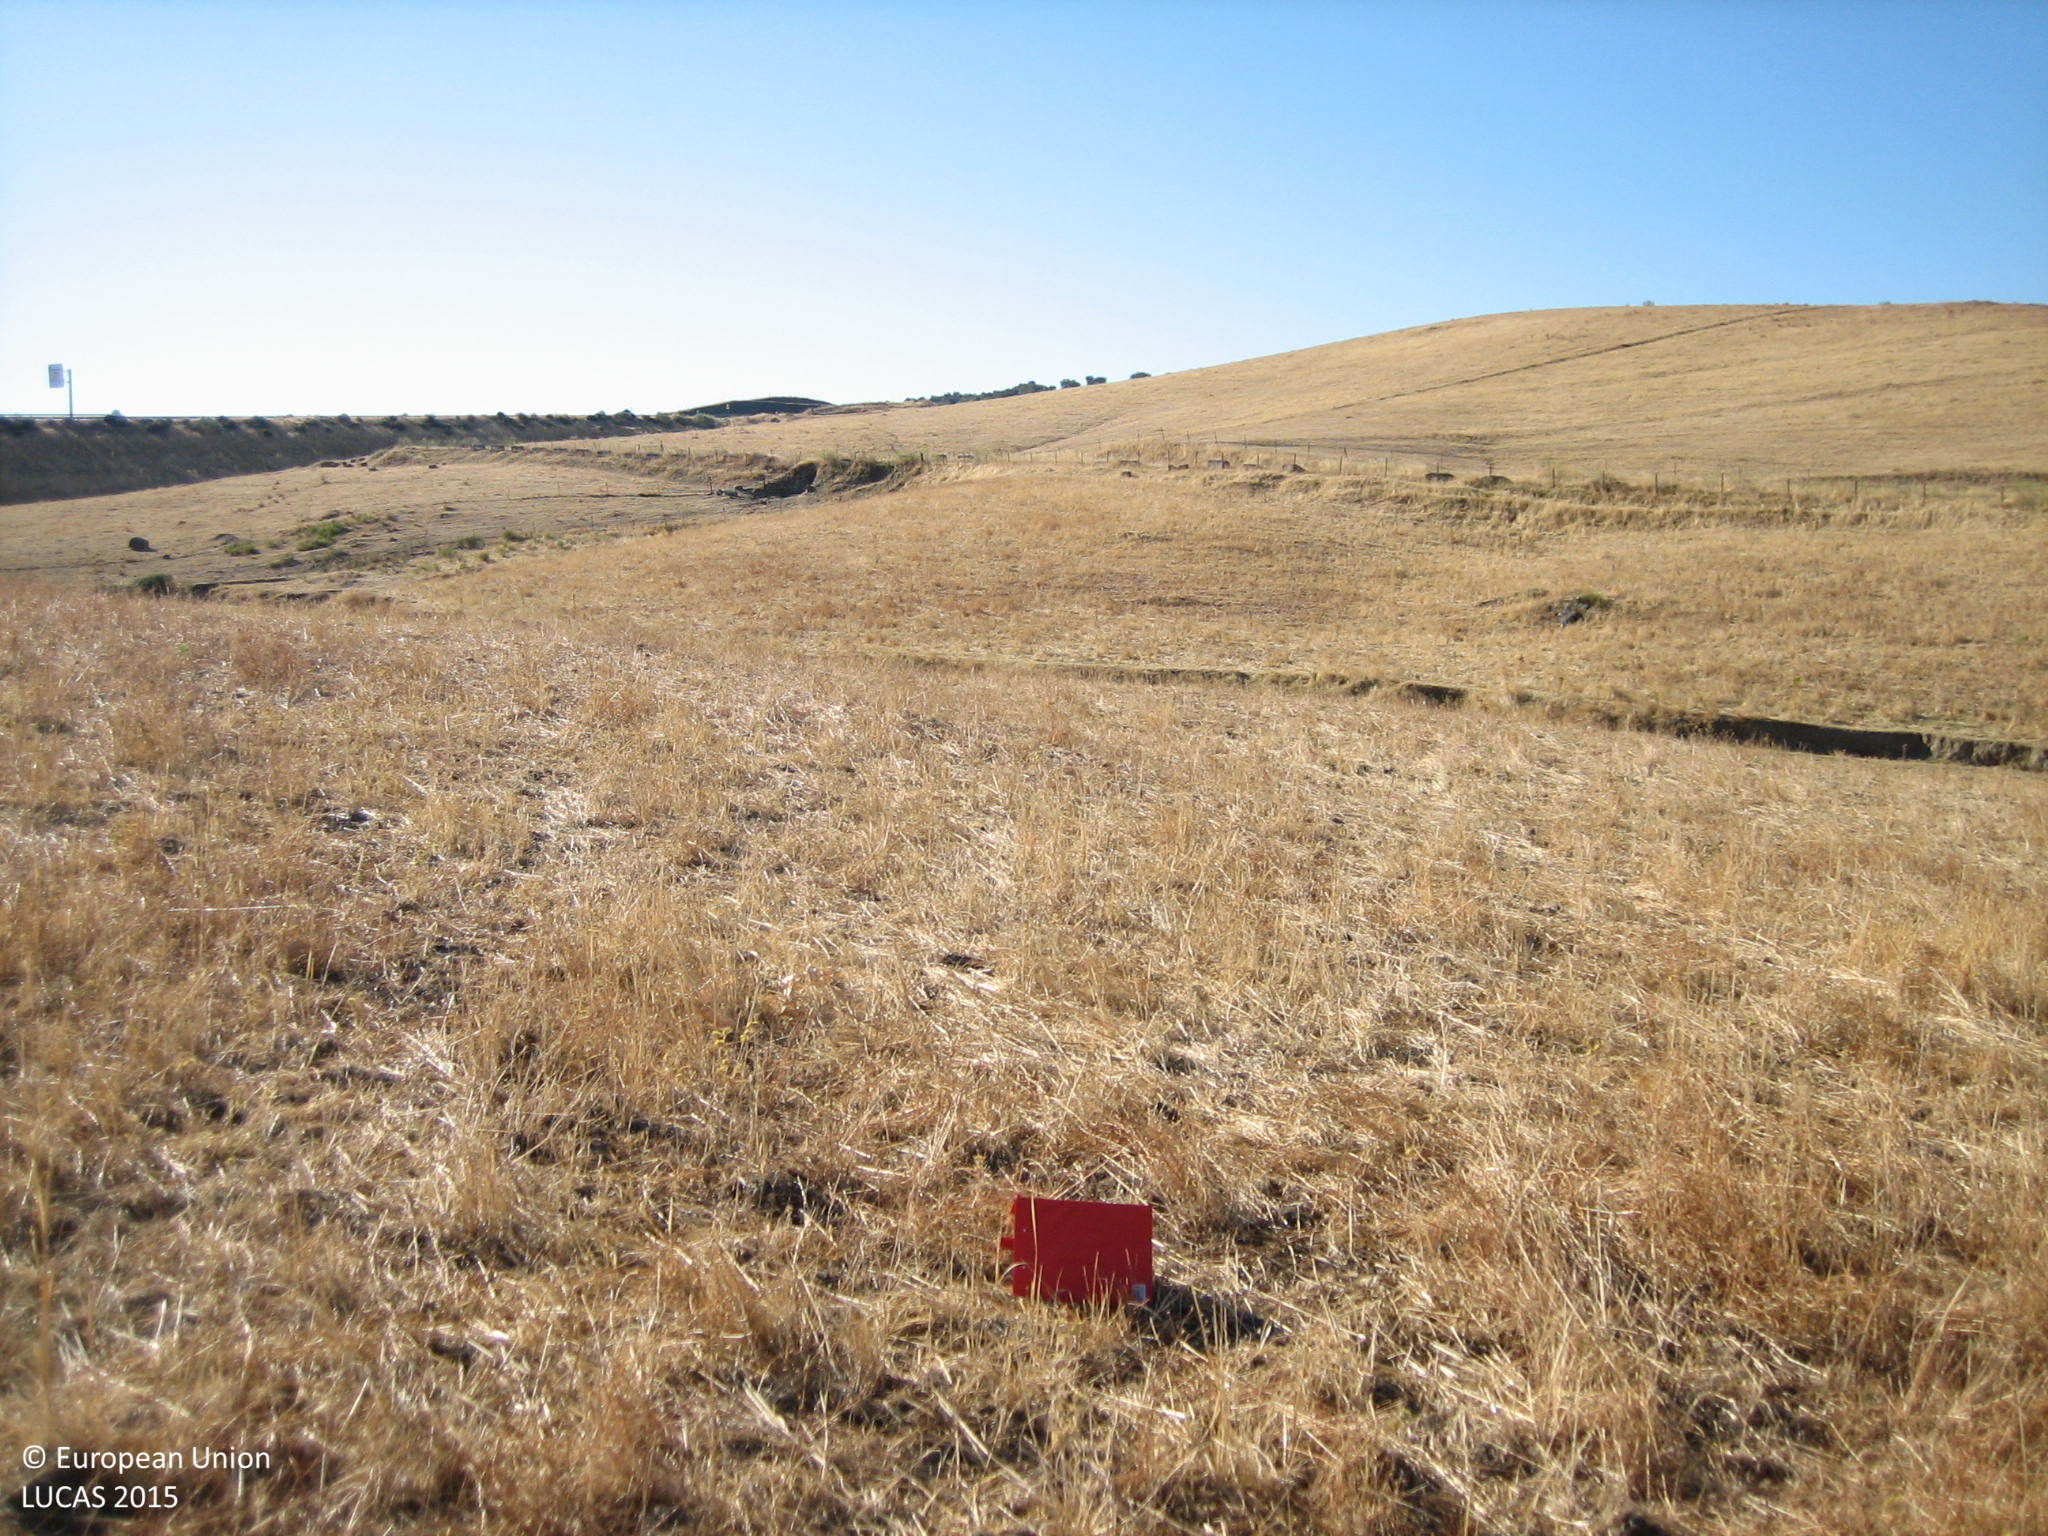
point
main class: Grassland
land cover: Grassland without tree/shrub cover
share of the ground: > 75 %
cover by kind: herbaceous plants 80 %, consolidated bare surface 20 %
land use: Agriculture (excluding fallow land and kitchen gardens)
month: August
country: ES
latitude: 38.1420
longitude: -6.2792
